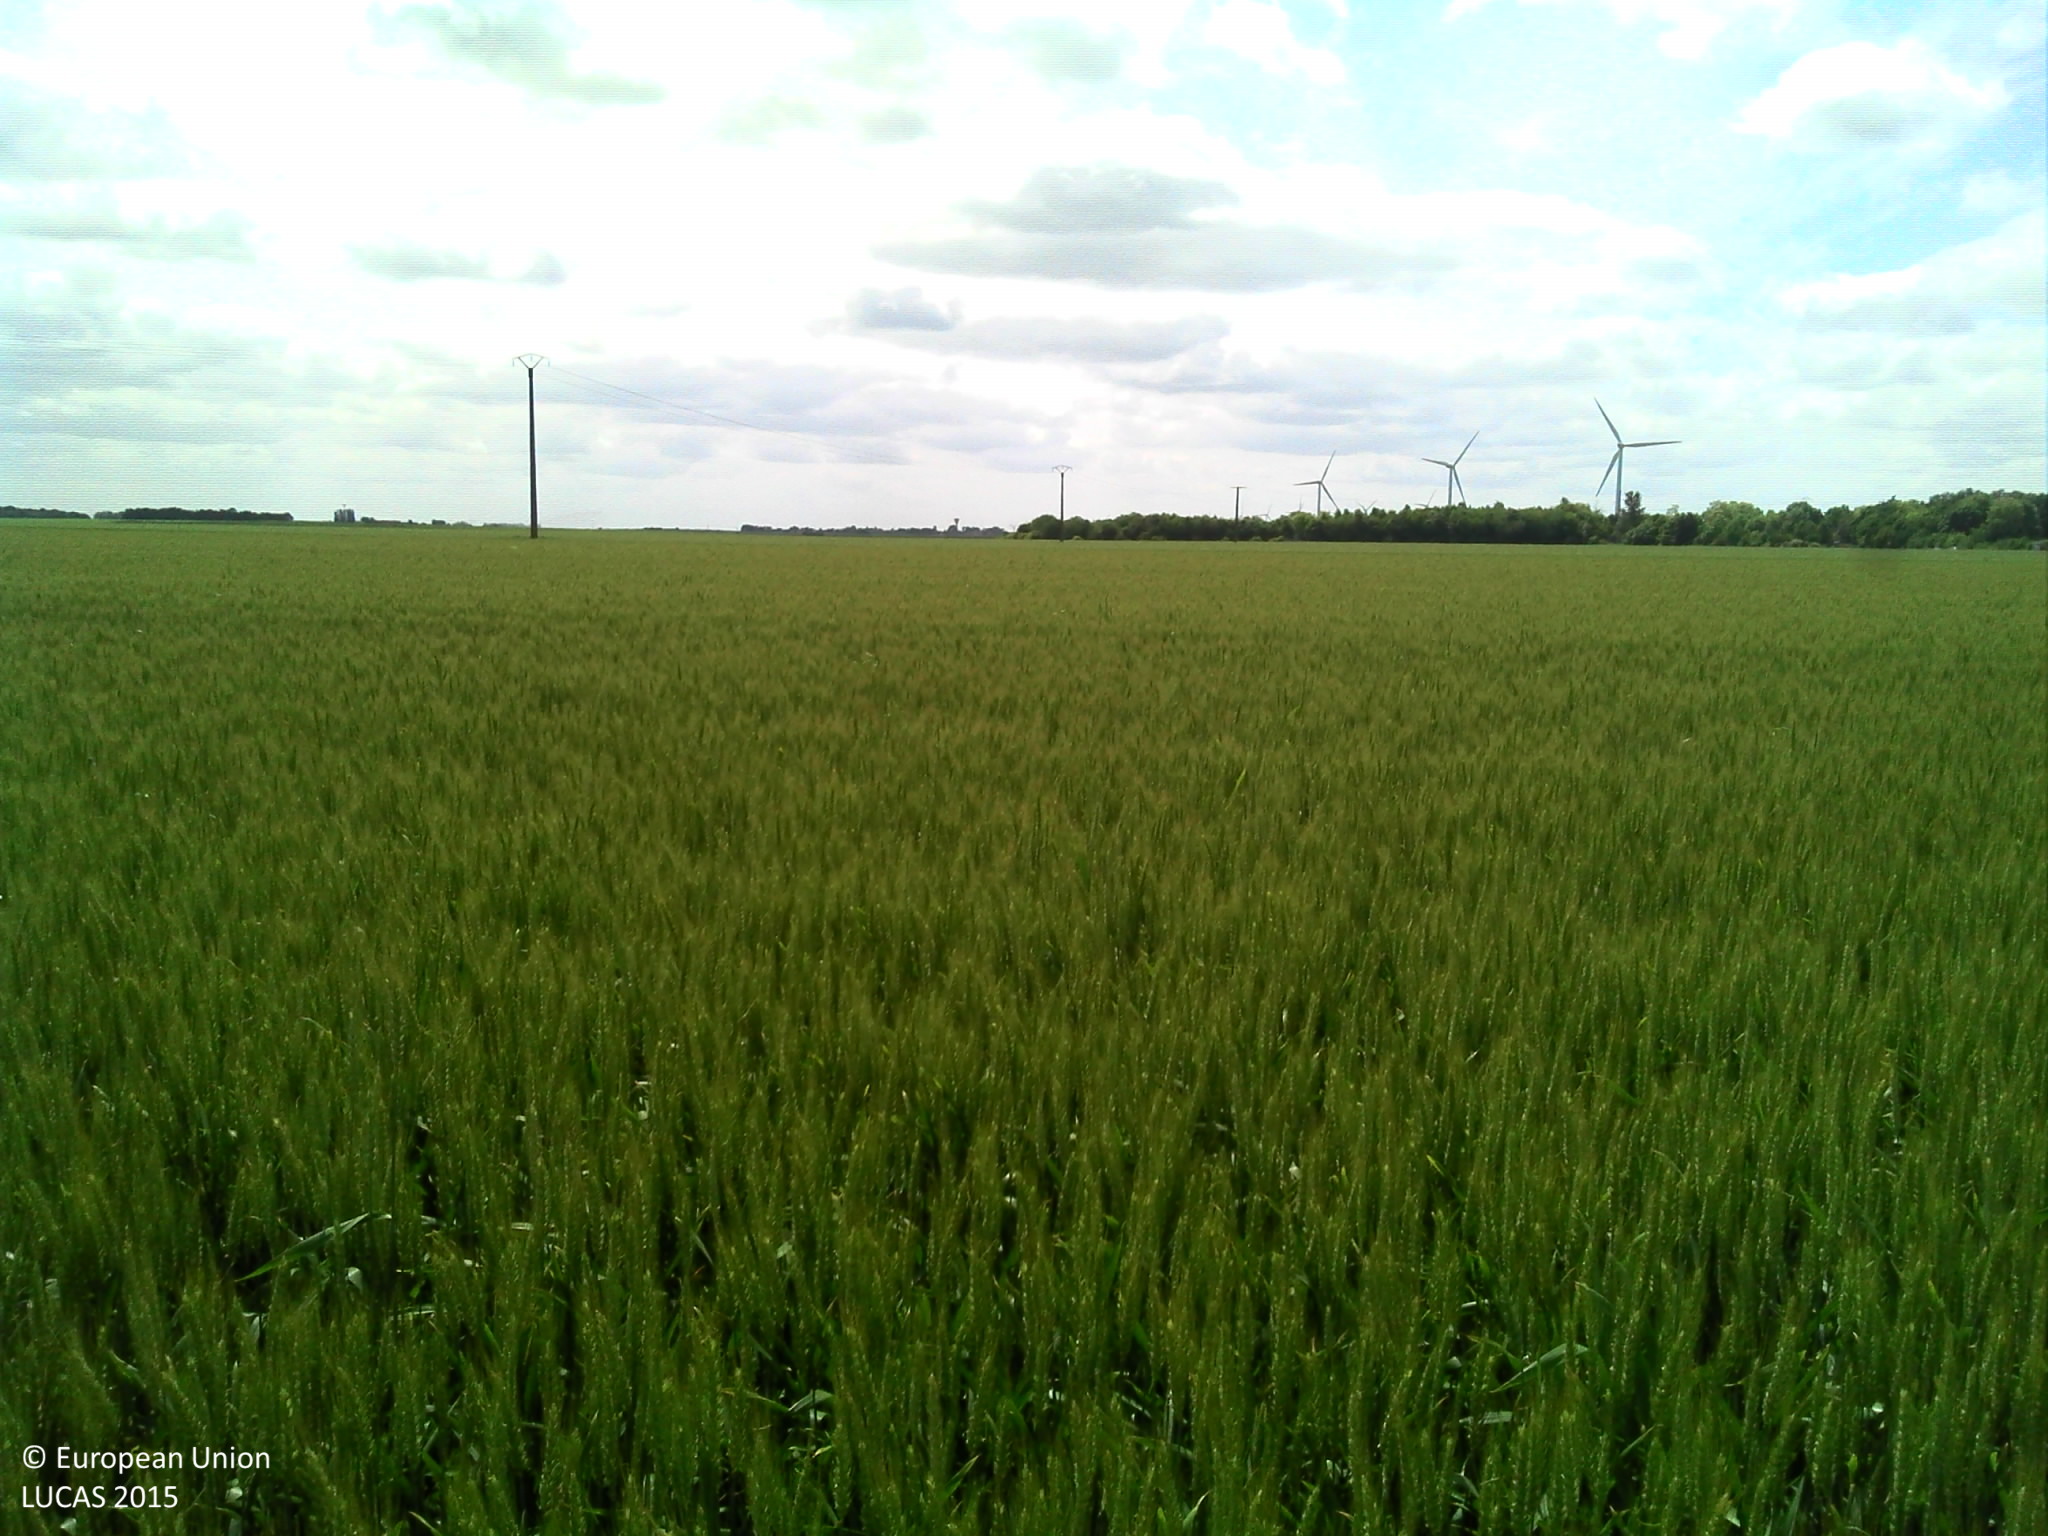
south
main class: Cropland
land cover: Common wheat
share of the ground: > 75 %
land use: Agriculture (excluding fallow land and kitchen gardens)
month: June
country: FR
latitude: 48.3950
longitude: 1.8961
